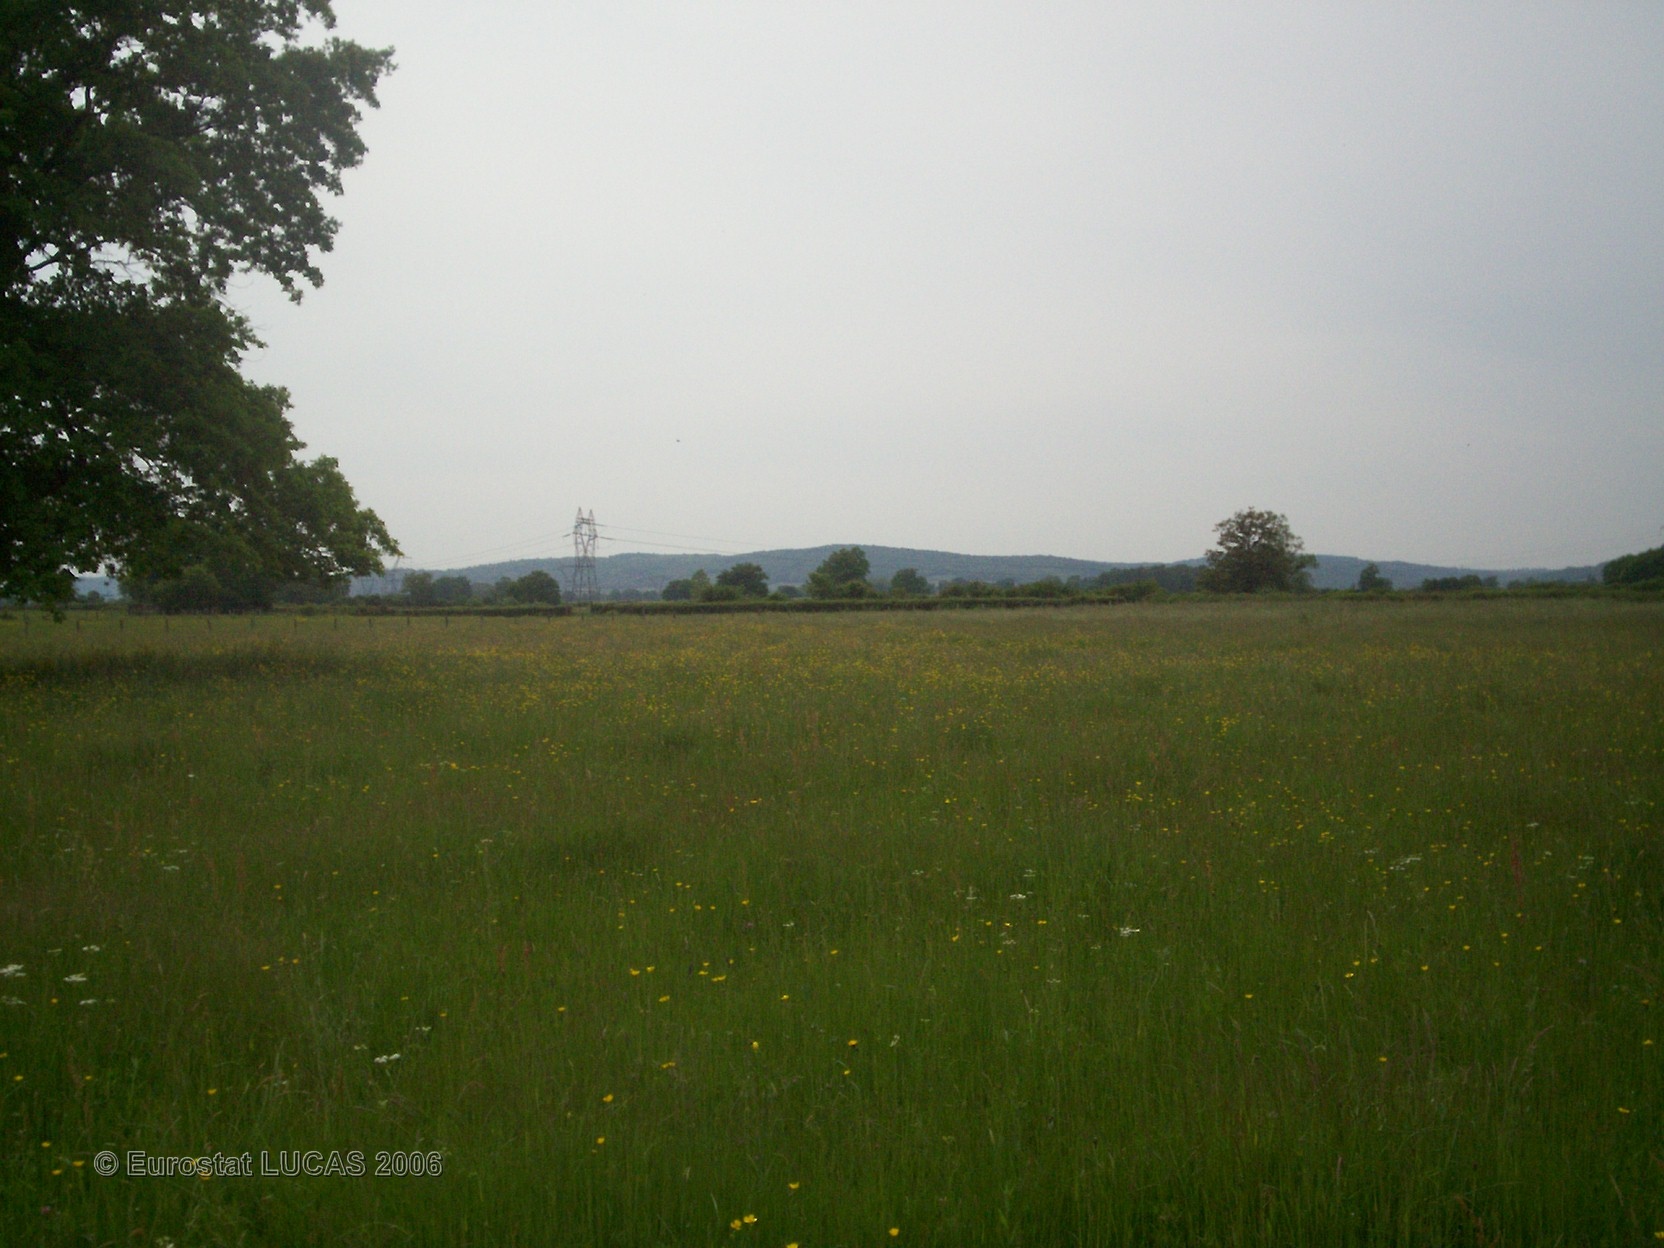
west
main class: Grassland
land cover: Grassland without tree/shrub cover
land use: Agriculture (excluding fallow land and kitchen gardens)
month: May
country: FR
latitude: 46.6367
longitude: 4.7370
